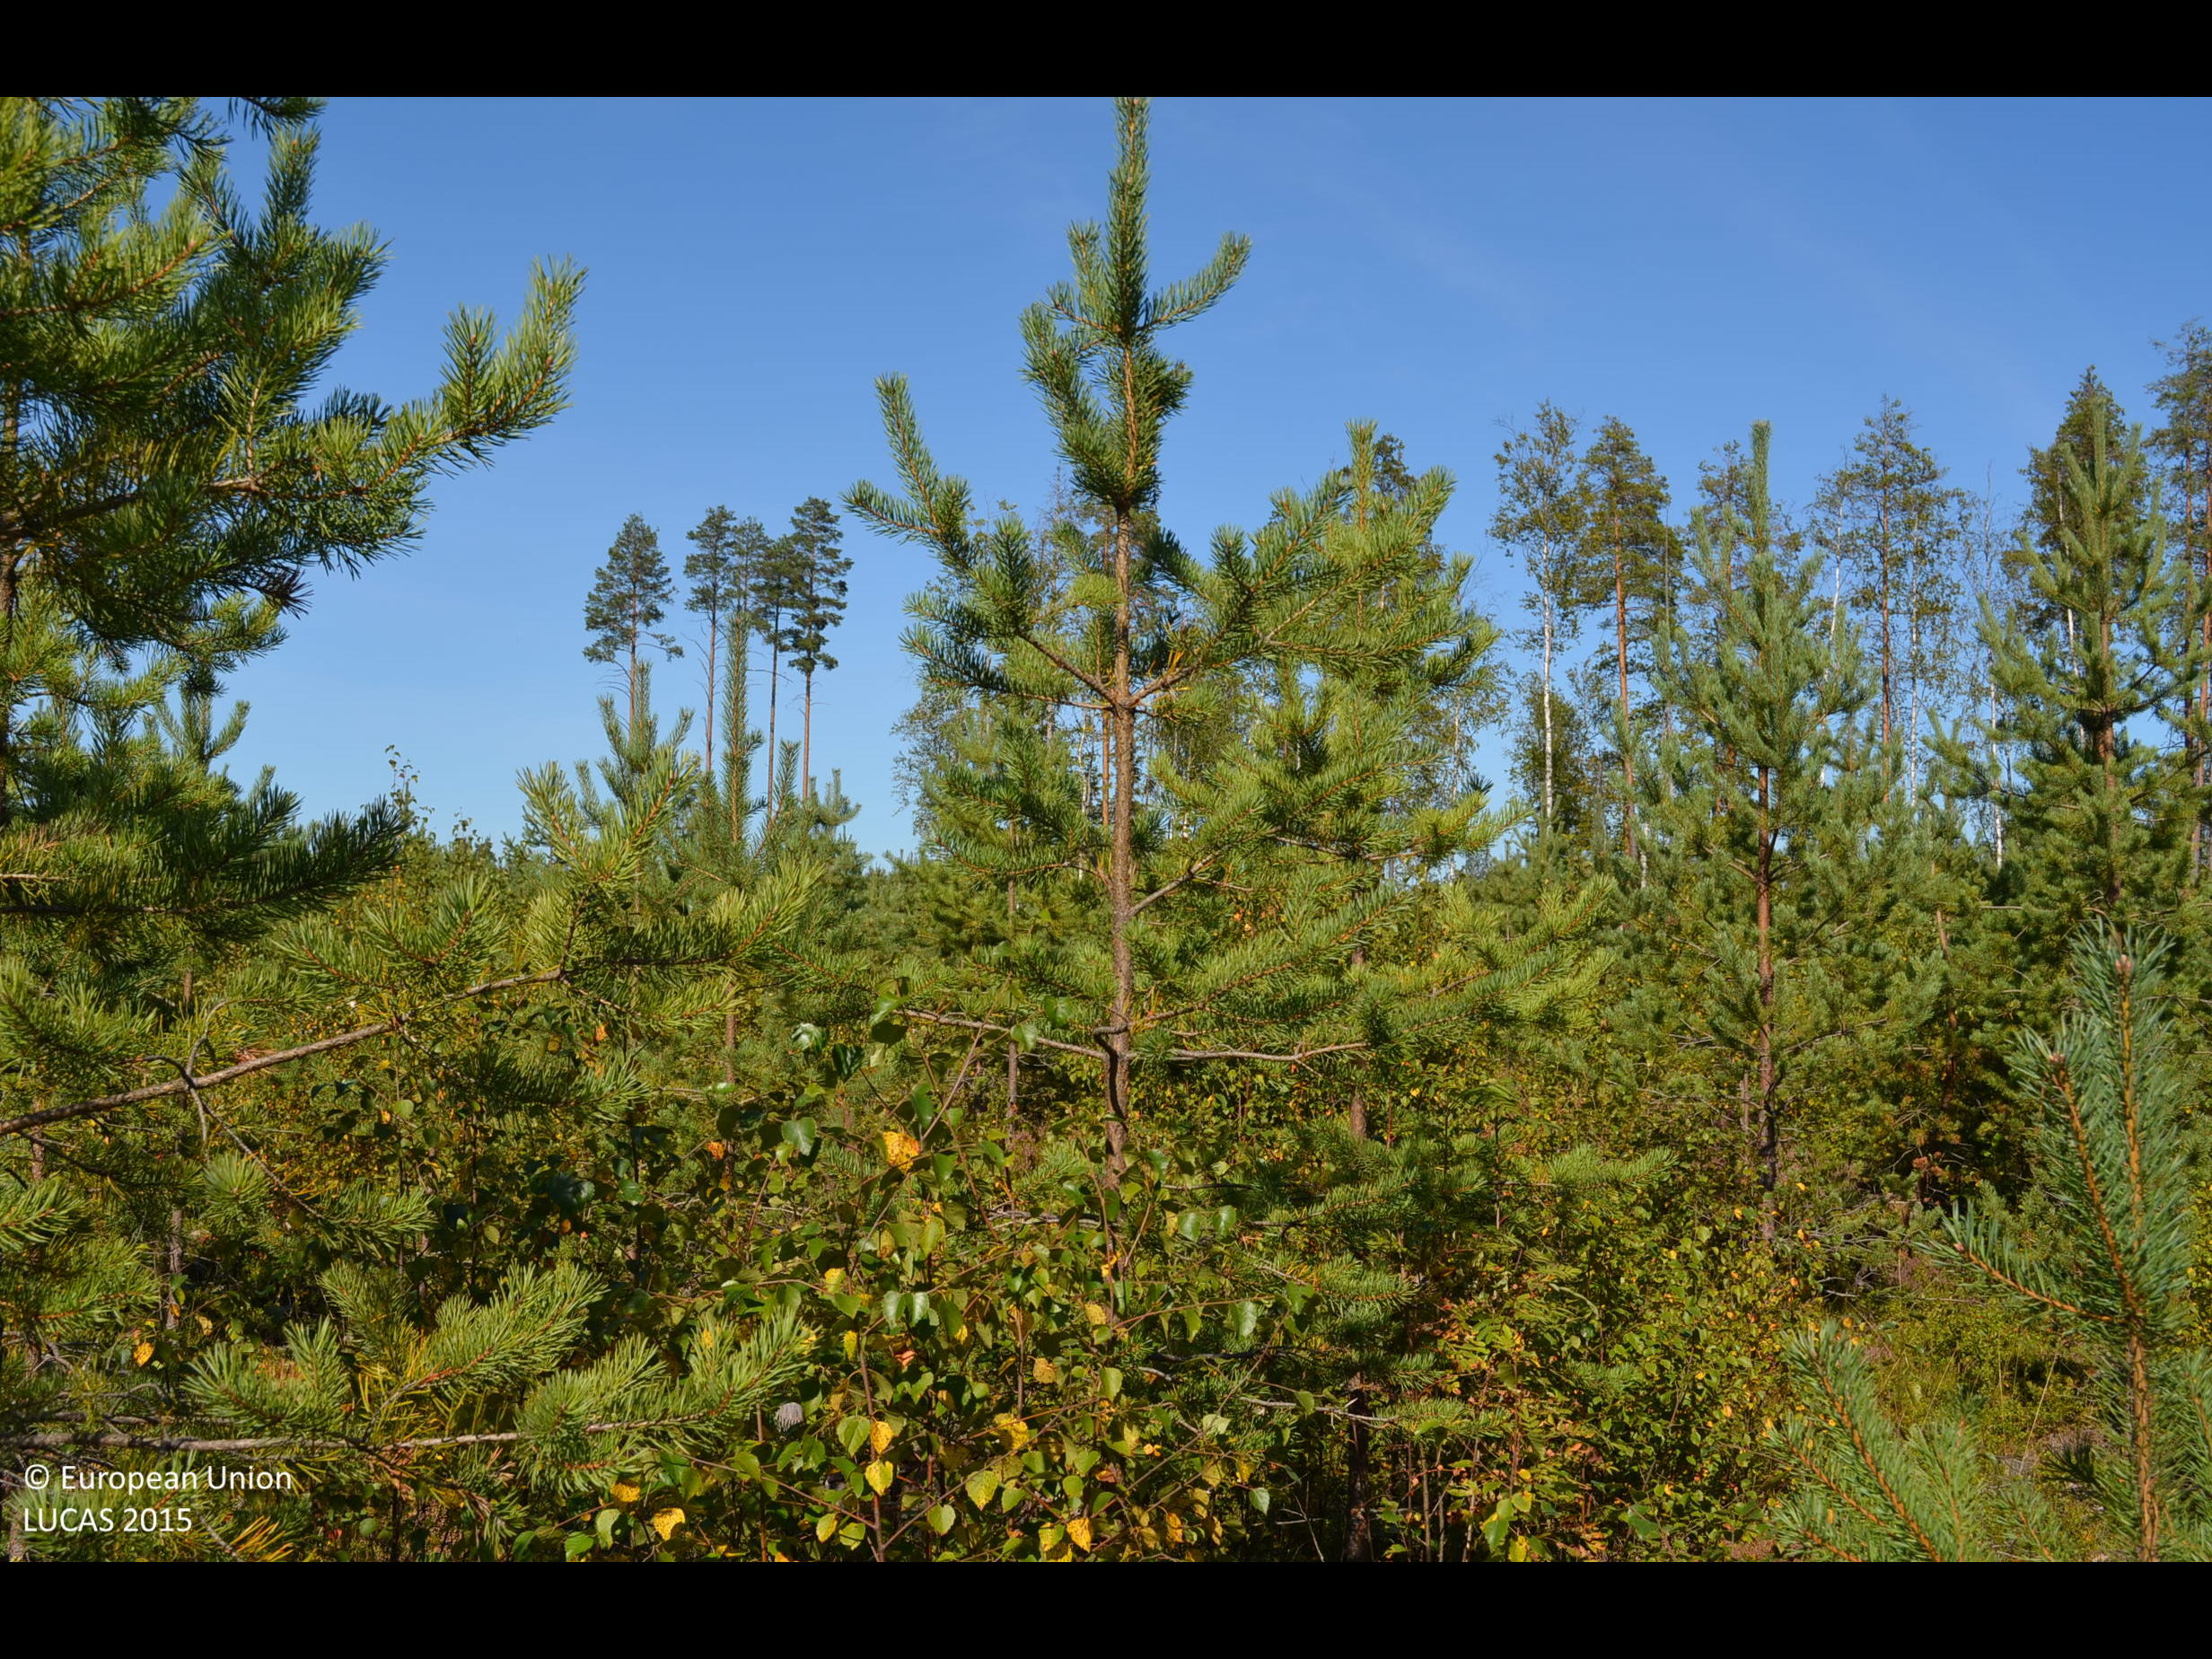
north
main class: Woodland
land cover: Pine dominated mixed woodland
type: boreal forest
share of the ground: > 75 %
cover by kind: coniferous forest trees 55 %, shrubs 25 %, broadleaved forest trees 20 %
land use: Amenities, museums, leisure
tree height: < 5 m
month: August
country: FI
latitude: 62.5965
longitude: 23.8058
